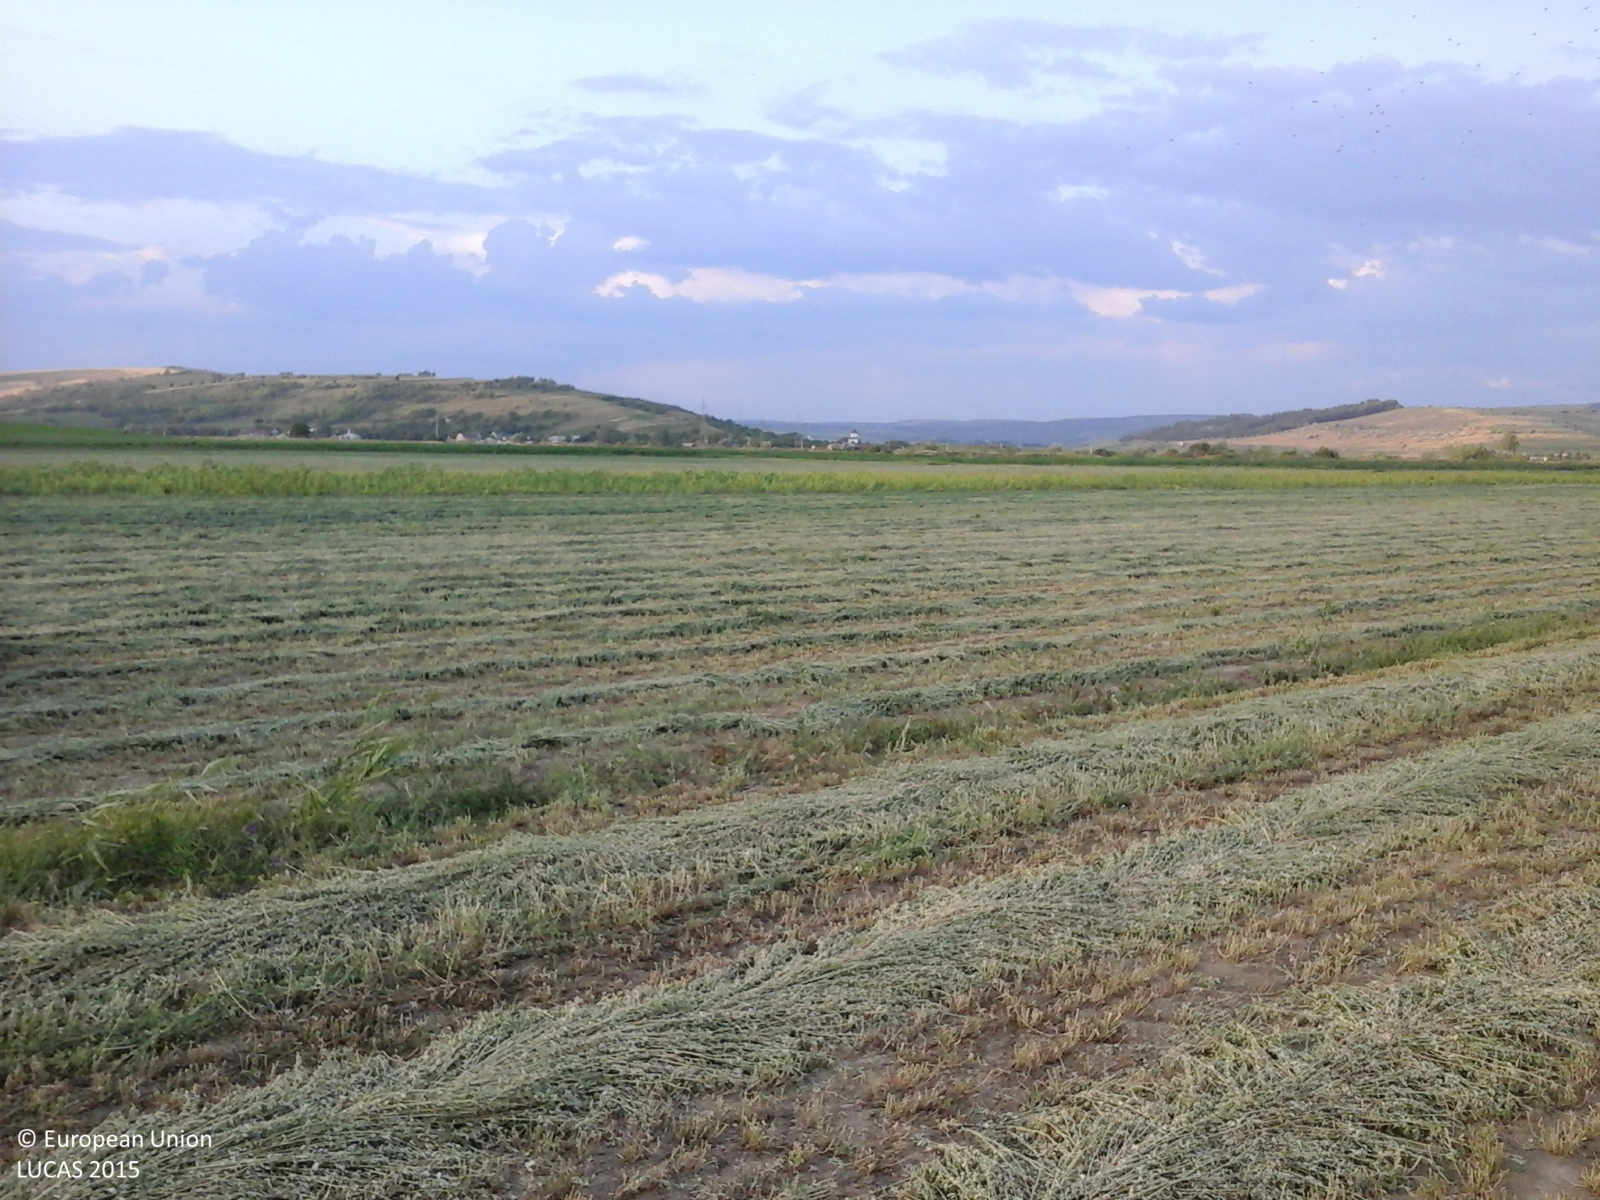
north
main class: Cropland
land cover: Lucerne
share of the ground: 25 - 50 %
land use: Agriculture (excluding fallow land and kitchen gardens)
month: June
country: RO
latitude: 46.8530
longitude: 27.7888
